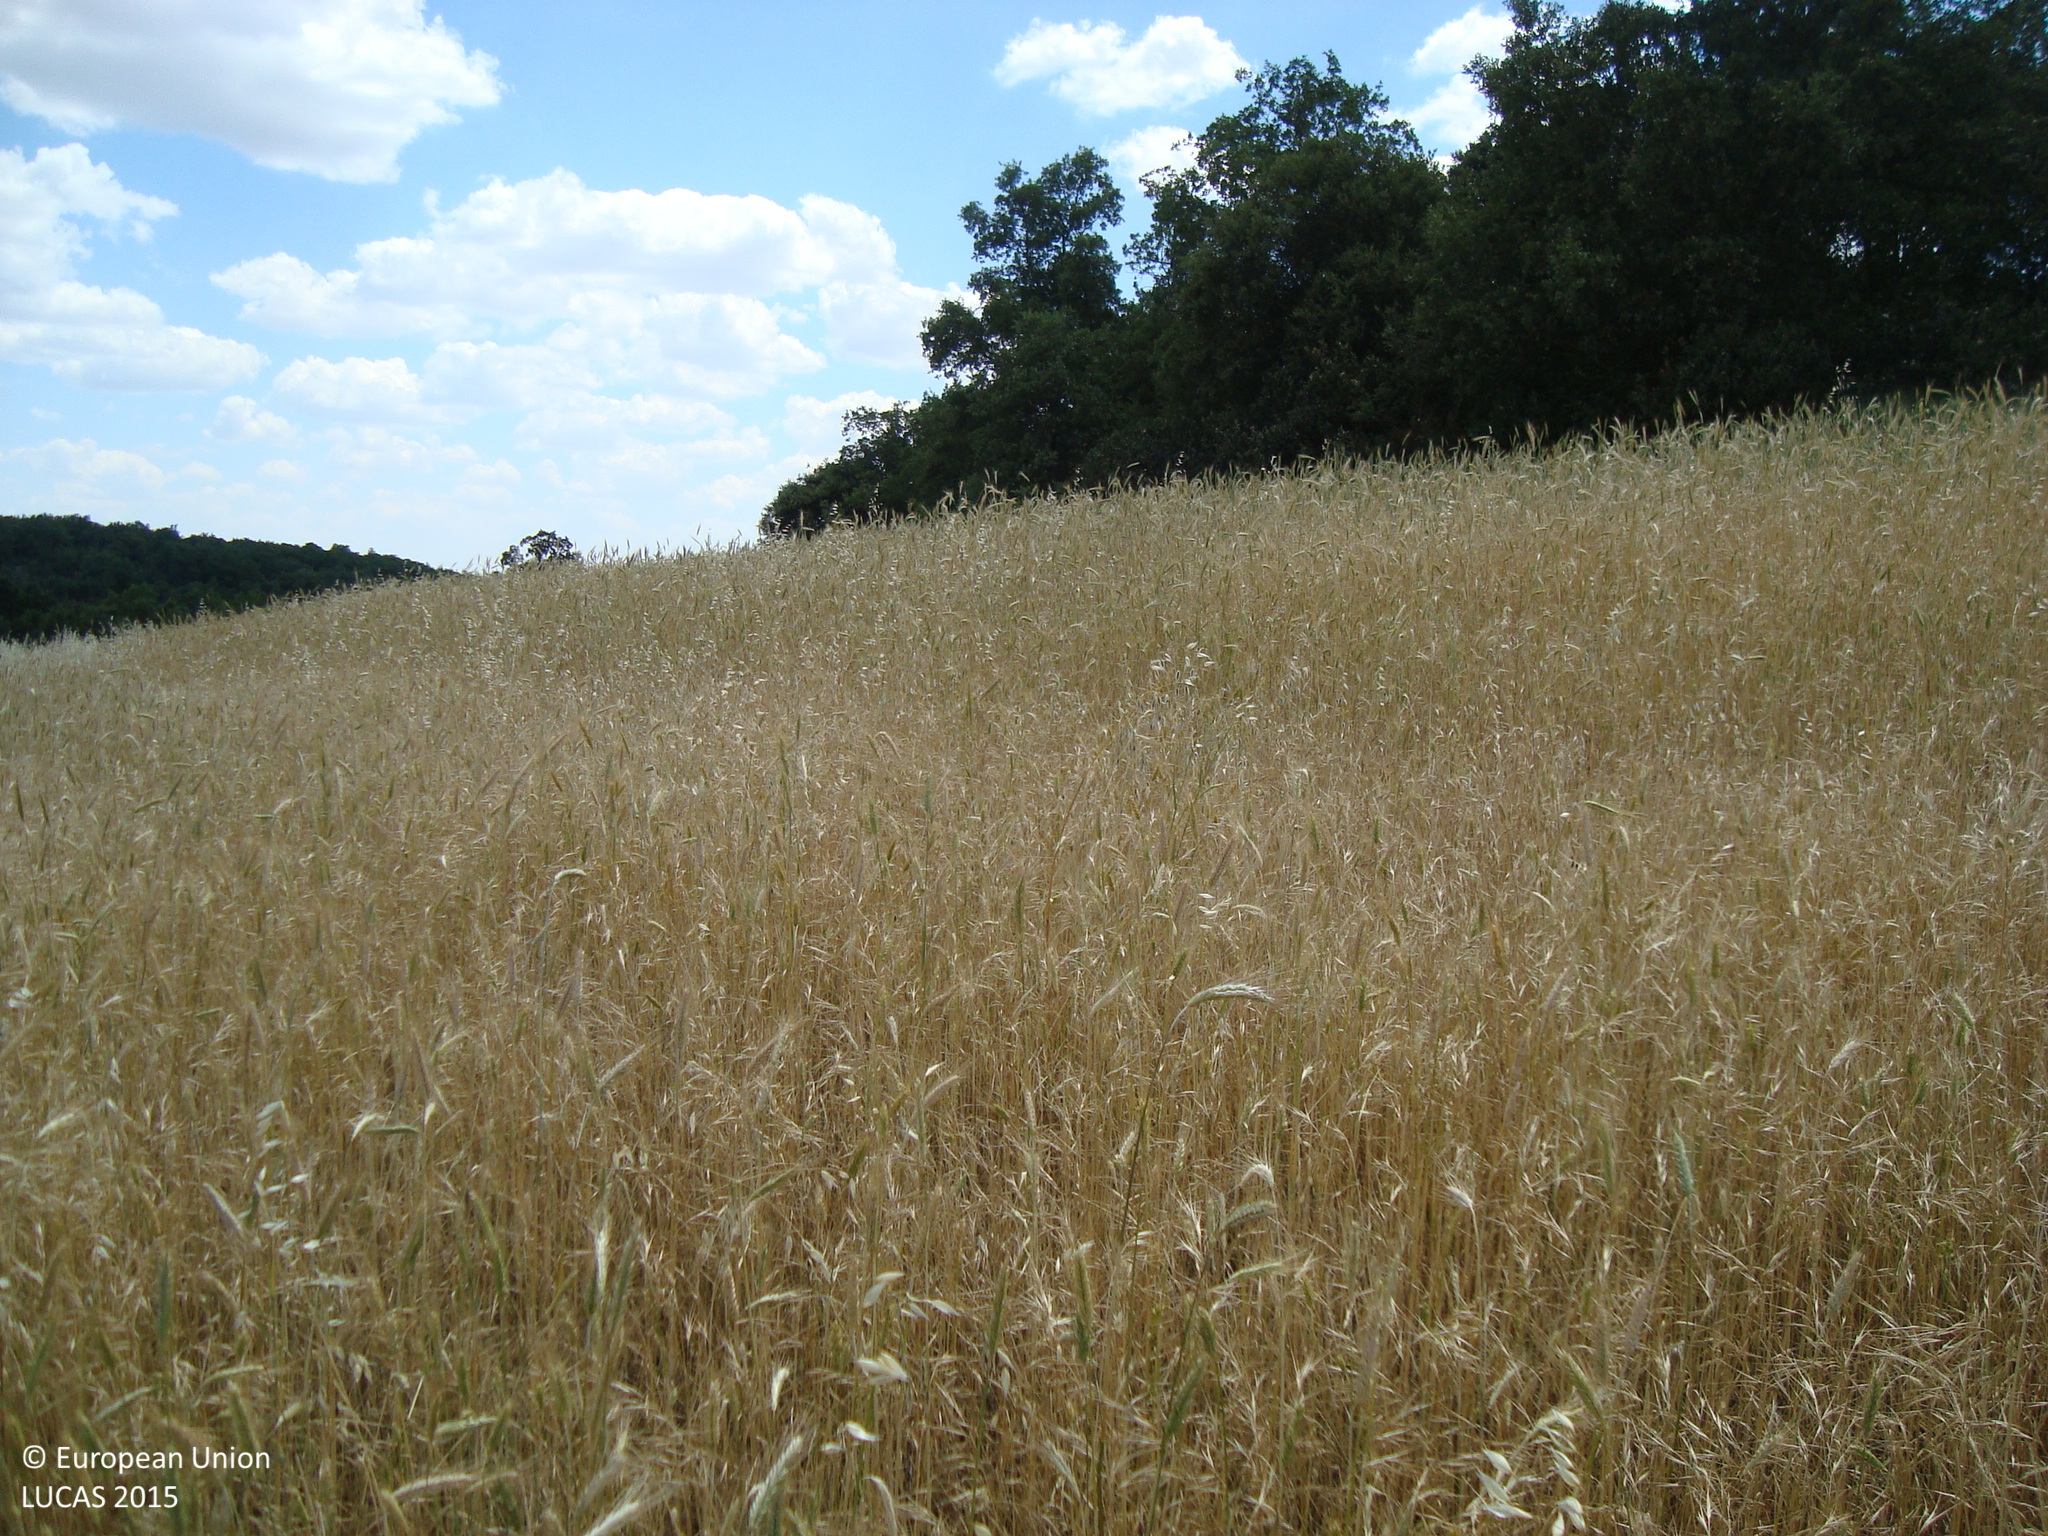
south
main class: Cropland
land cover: Mixed cereals for fodder
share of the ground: > 75 %
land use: Agriculture (excluding fallow land and kitchen gardens)
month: June
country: ES
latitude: 42.1364
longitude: -3.7179
